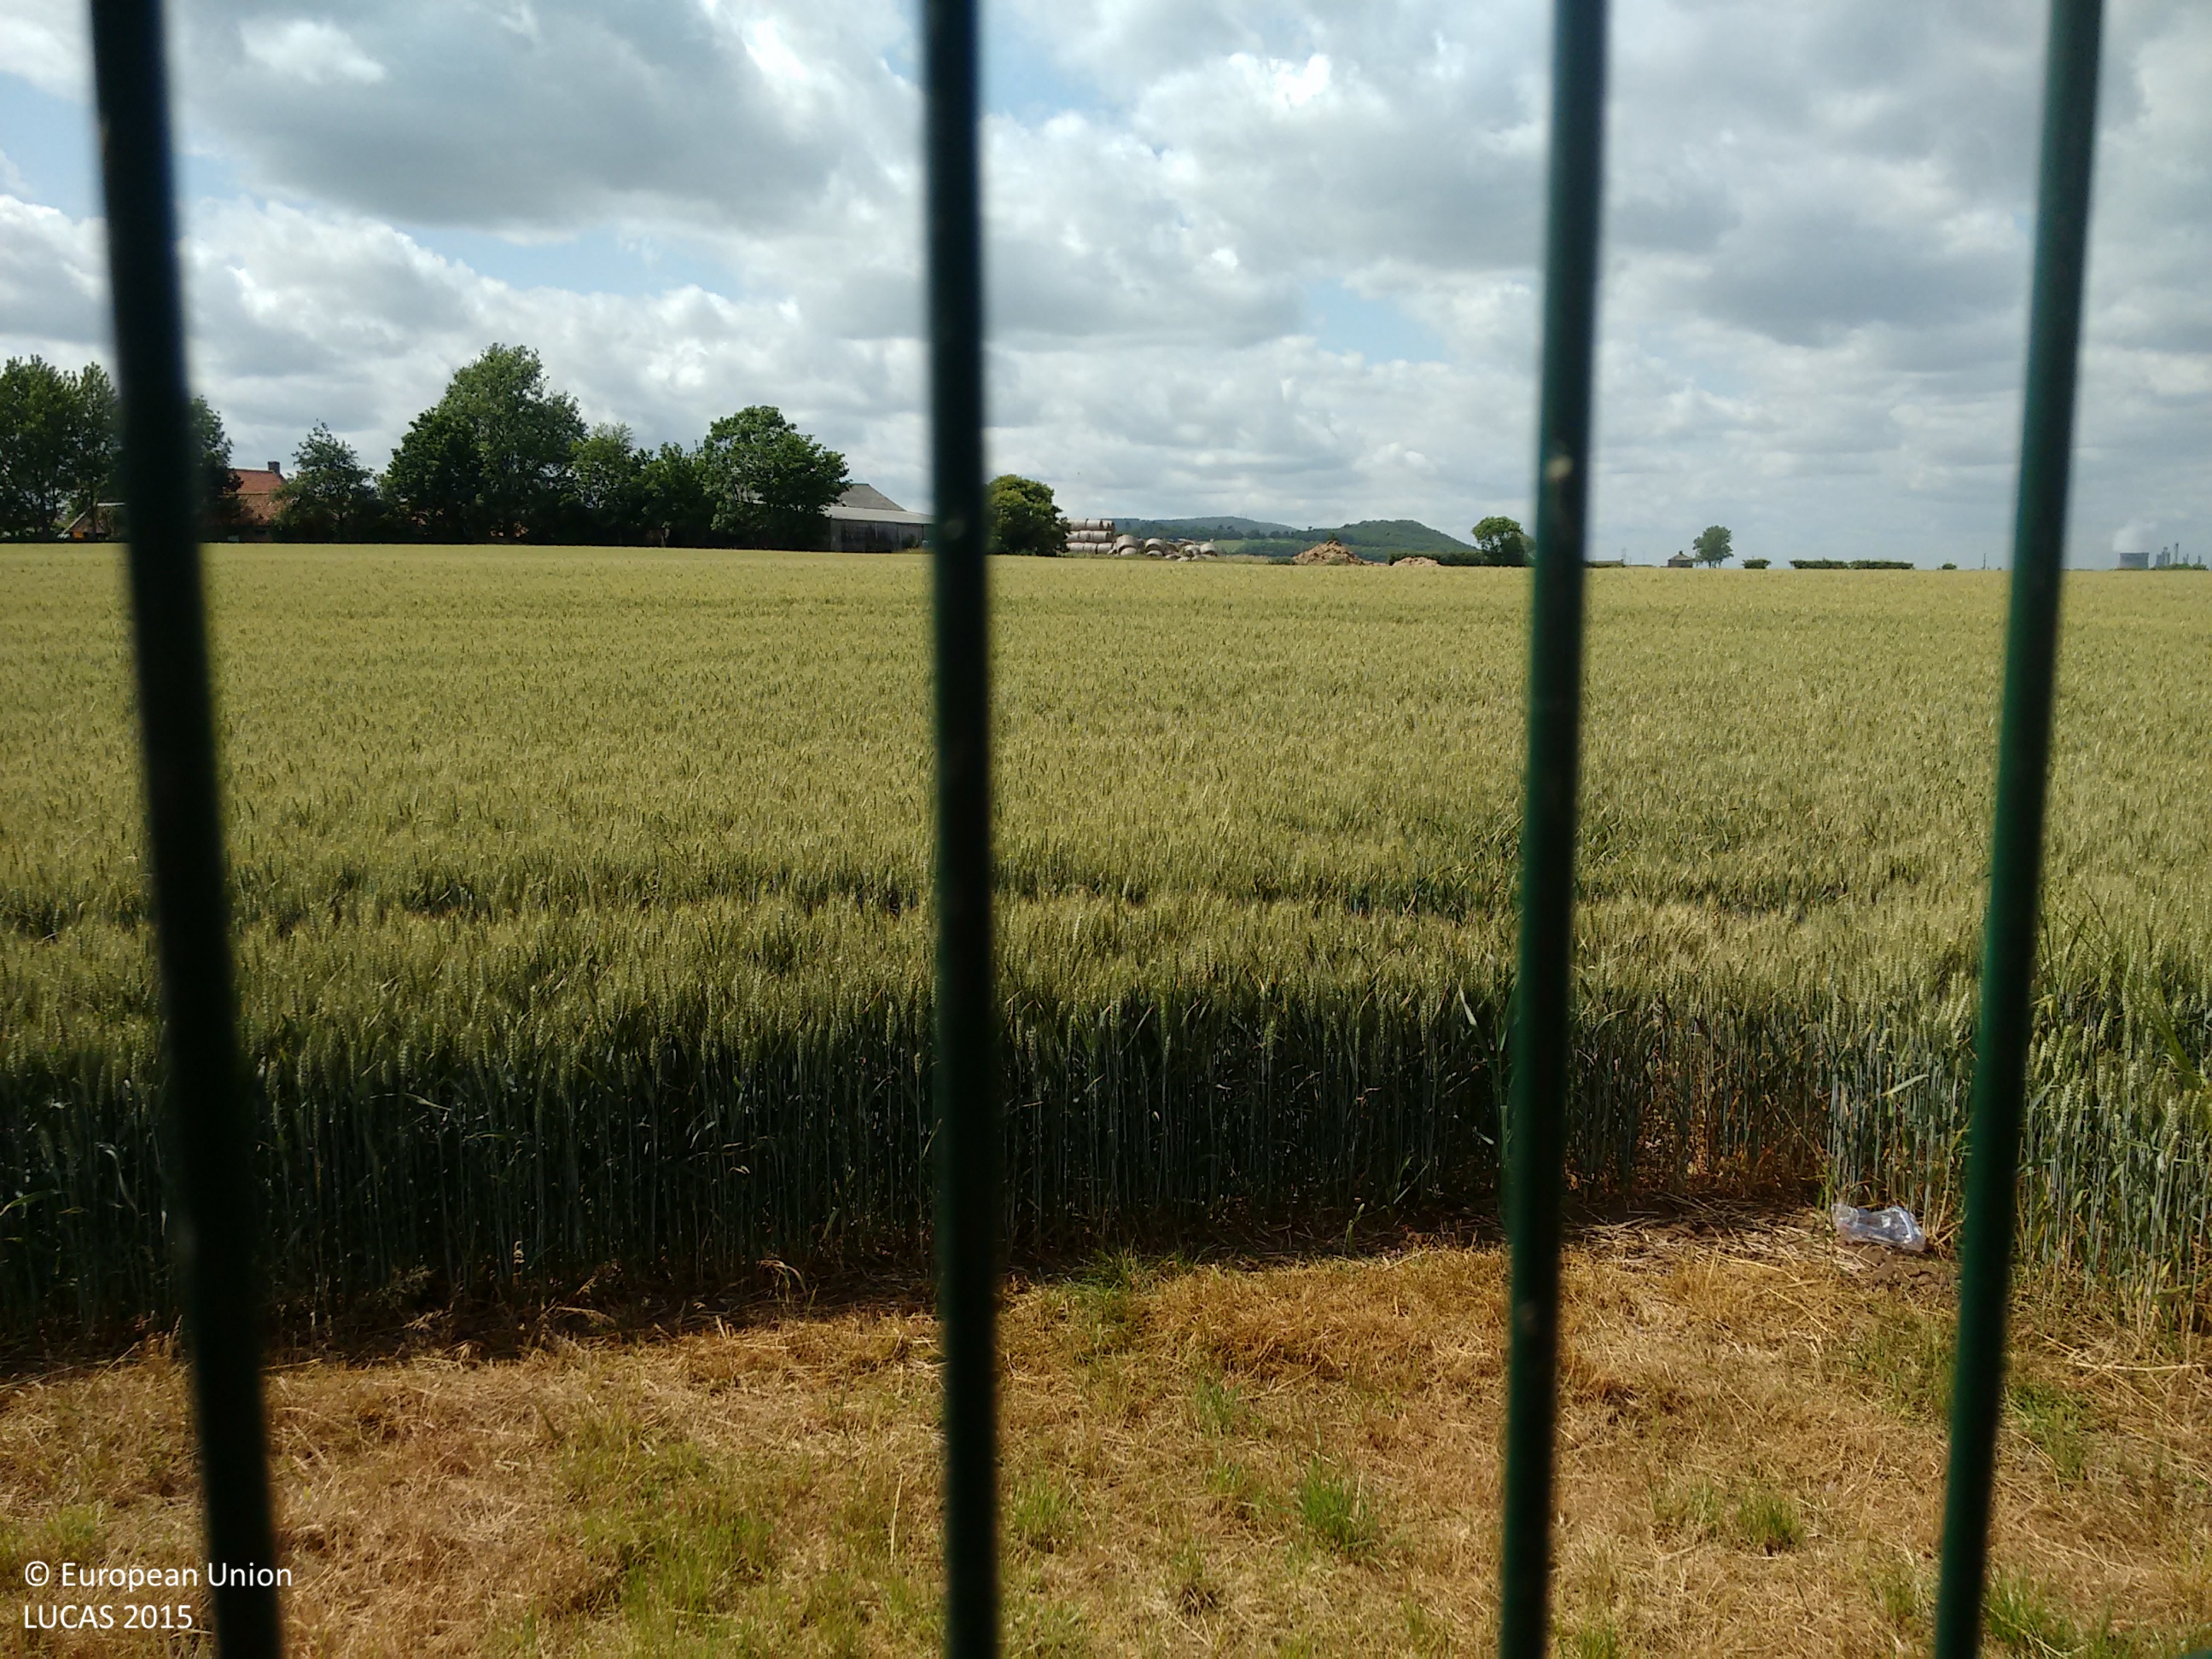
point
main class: Cropland
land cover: Common wheat
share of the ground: > 75 %
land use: Agriculture (excluding fallow land and kitchen gardens)
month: July
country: GB
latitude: 54.5836
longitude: -1.0434
